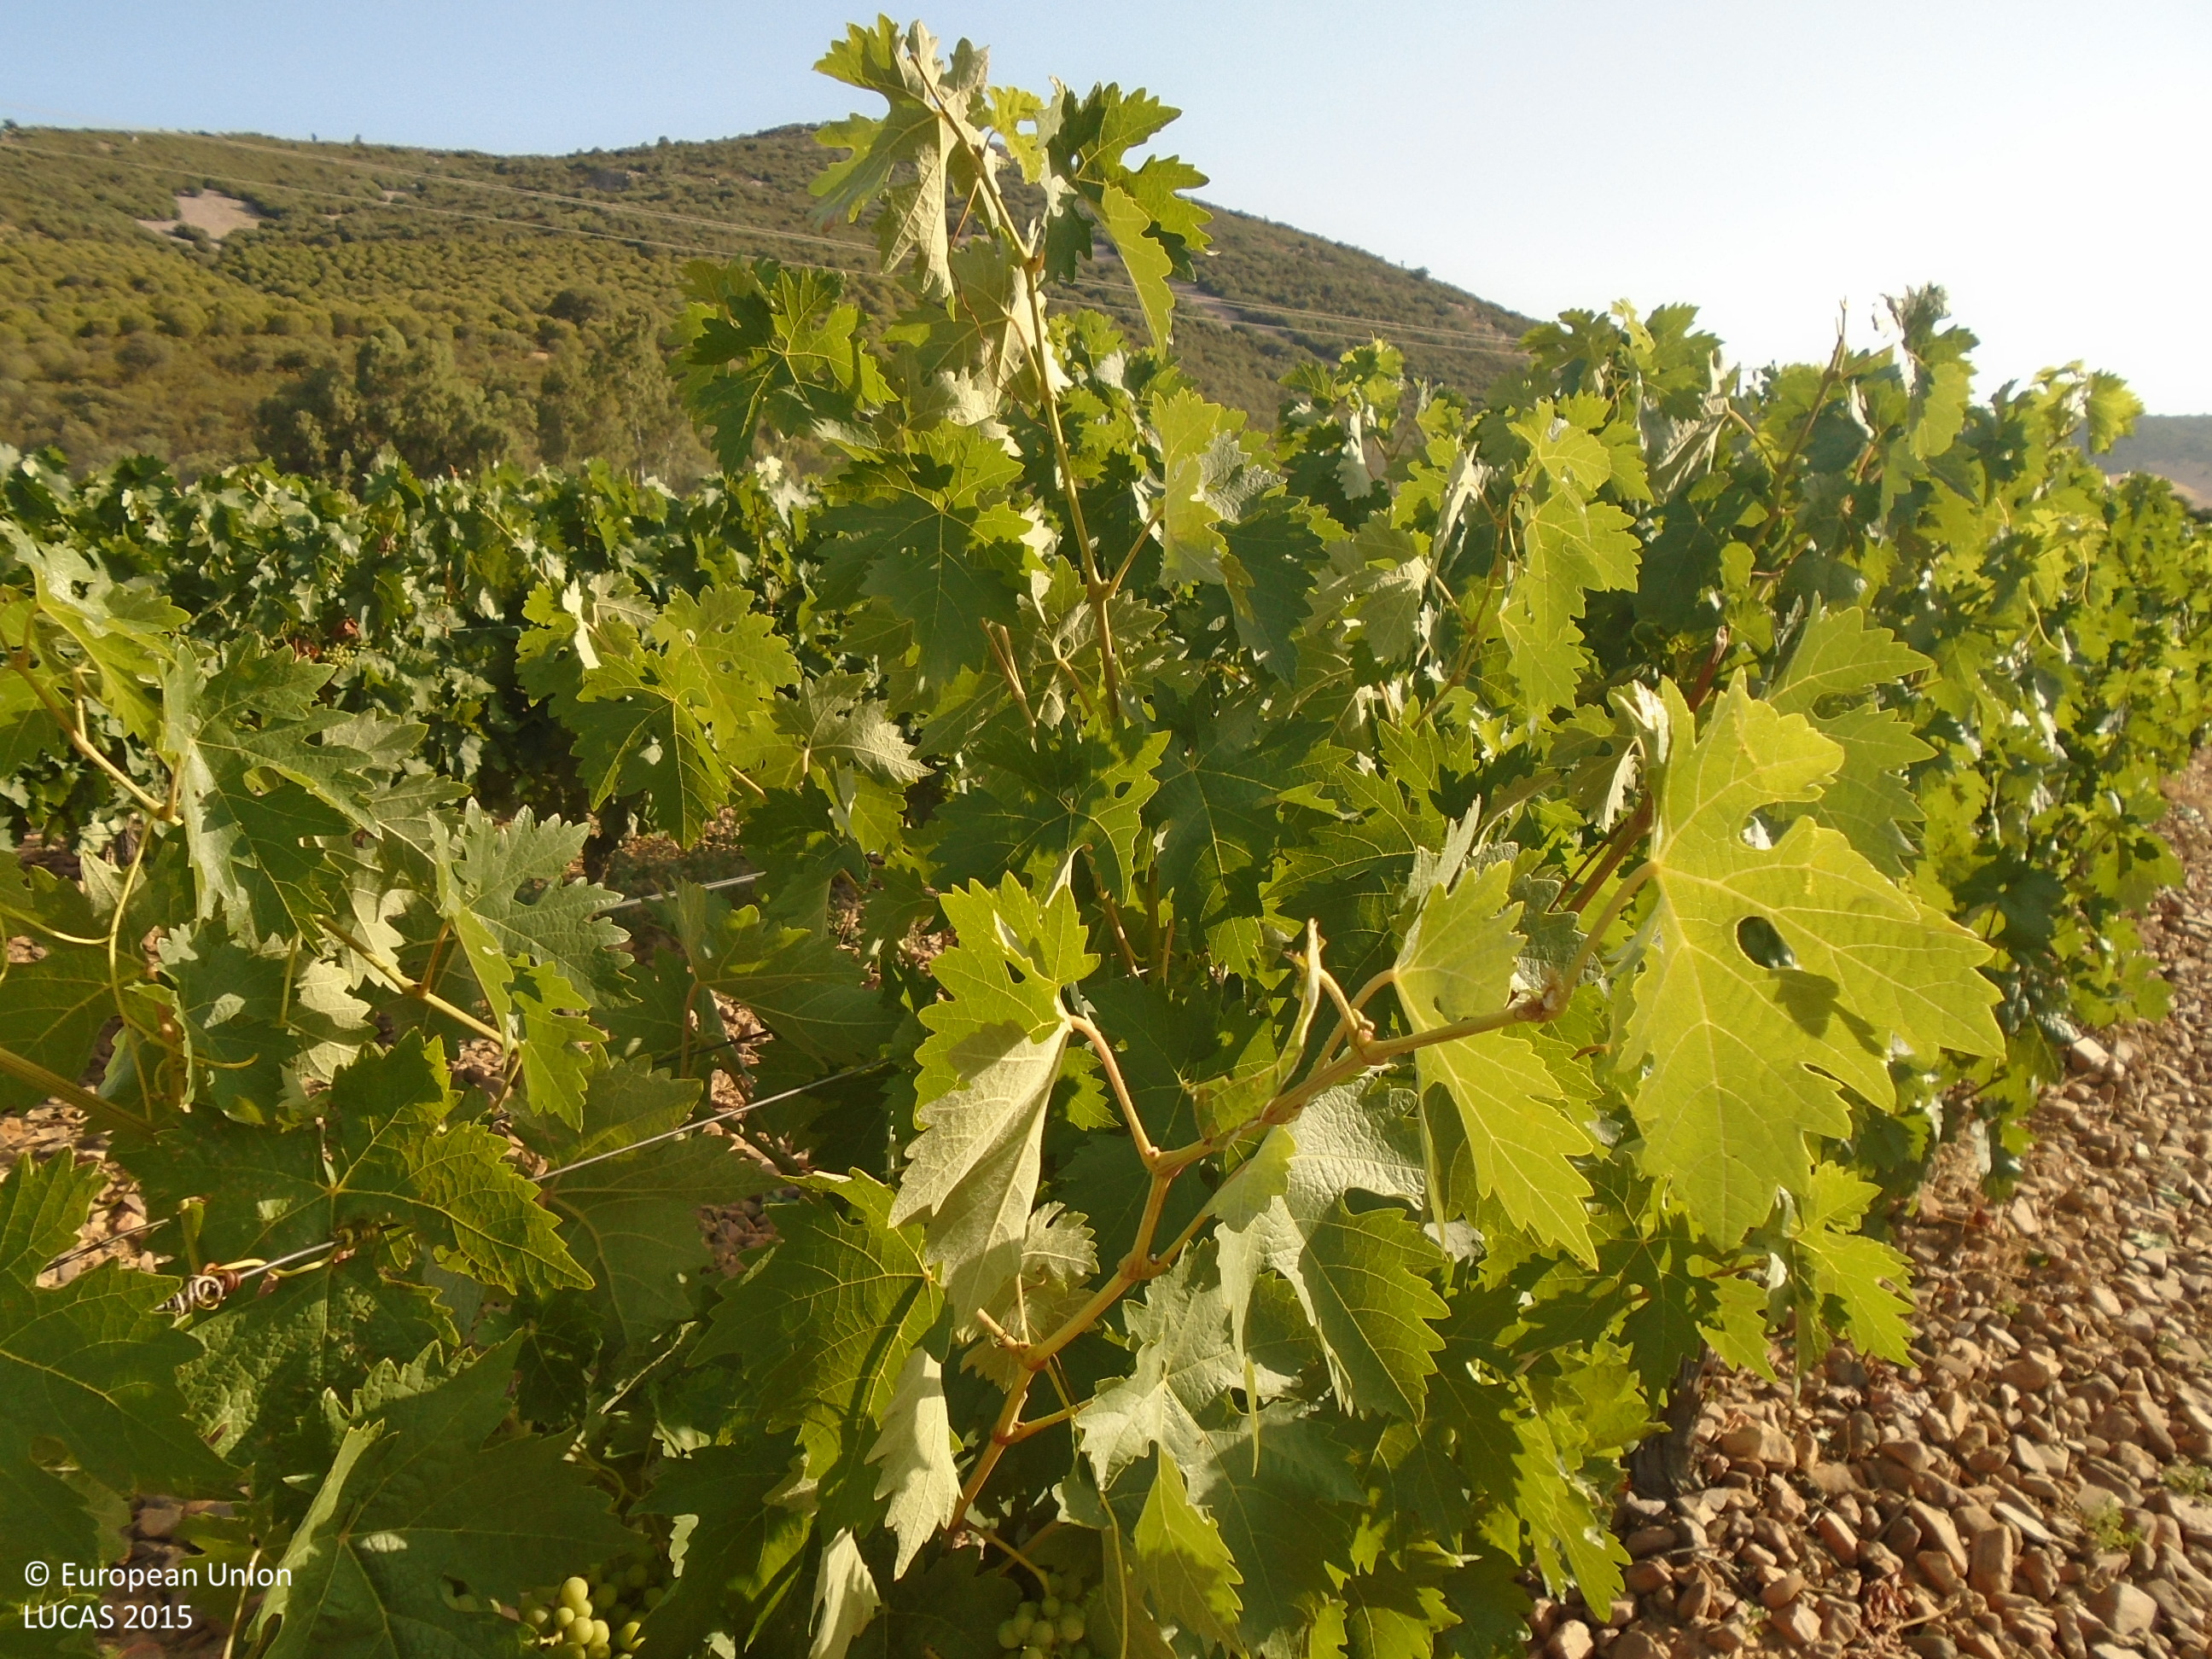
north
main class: Cropland
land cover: Vineyards
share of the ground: 10 - 25 %
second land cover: Other bare soil
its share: > 75 %
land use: Agriculture (excluding fallow land and kitchen gardens)
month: July
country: ES
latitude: 39.2783
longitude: -4.1117
